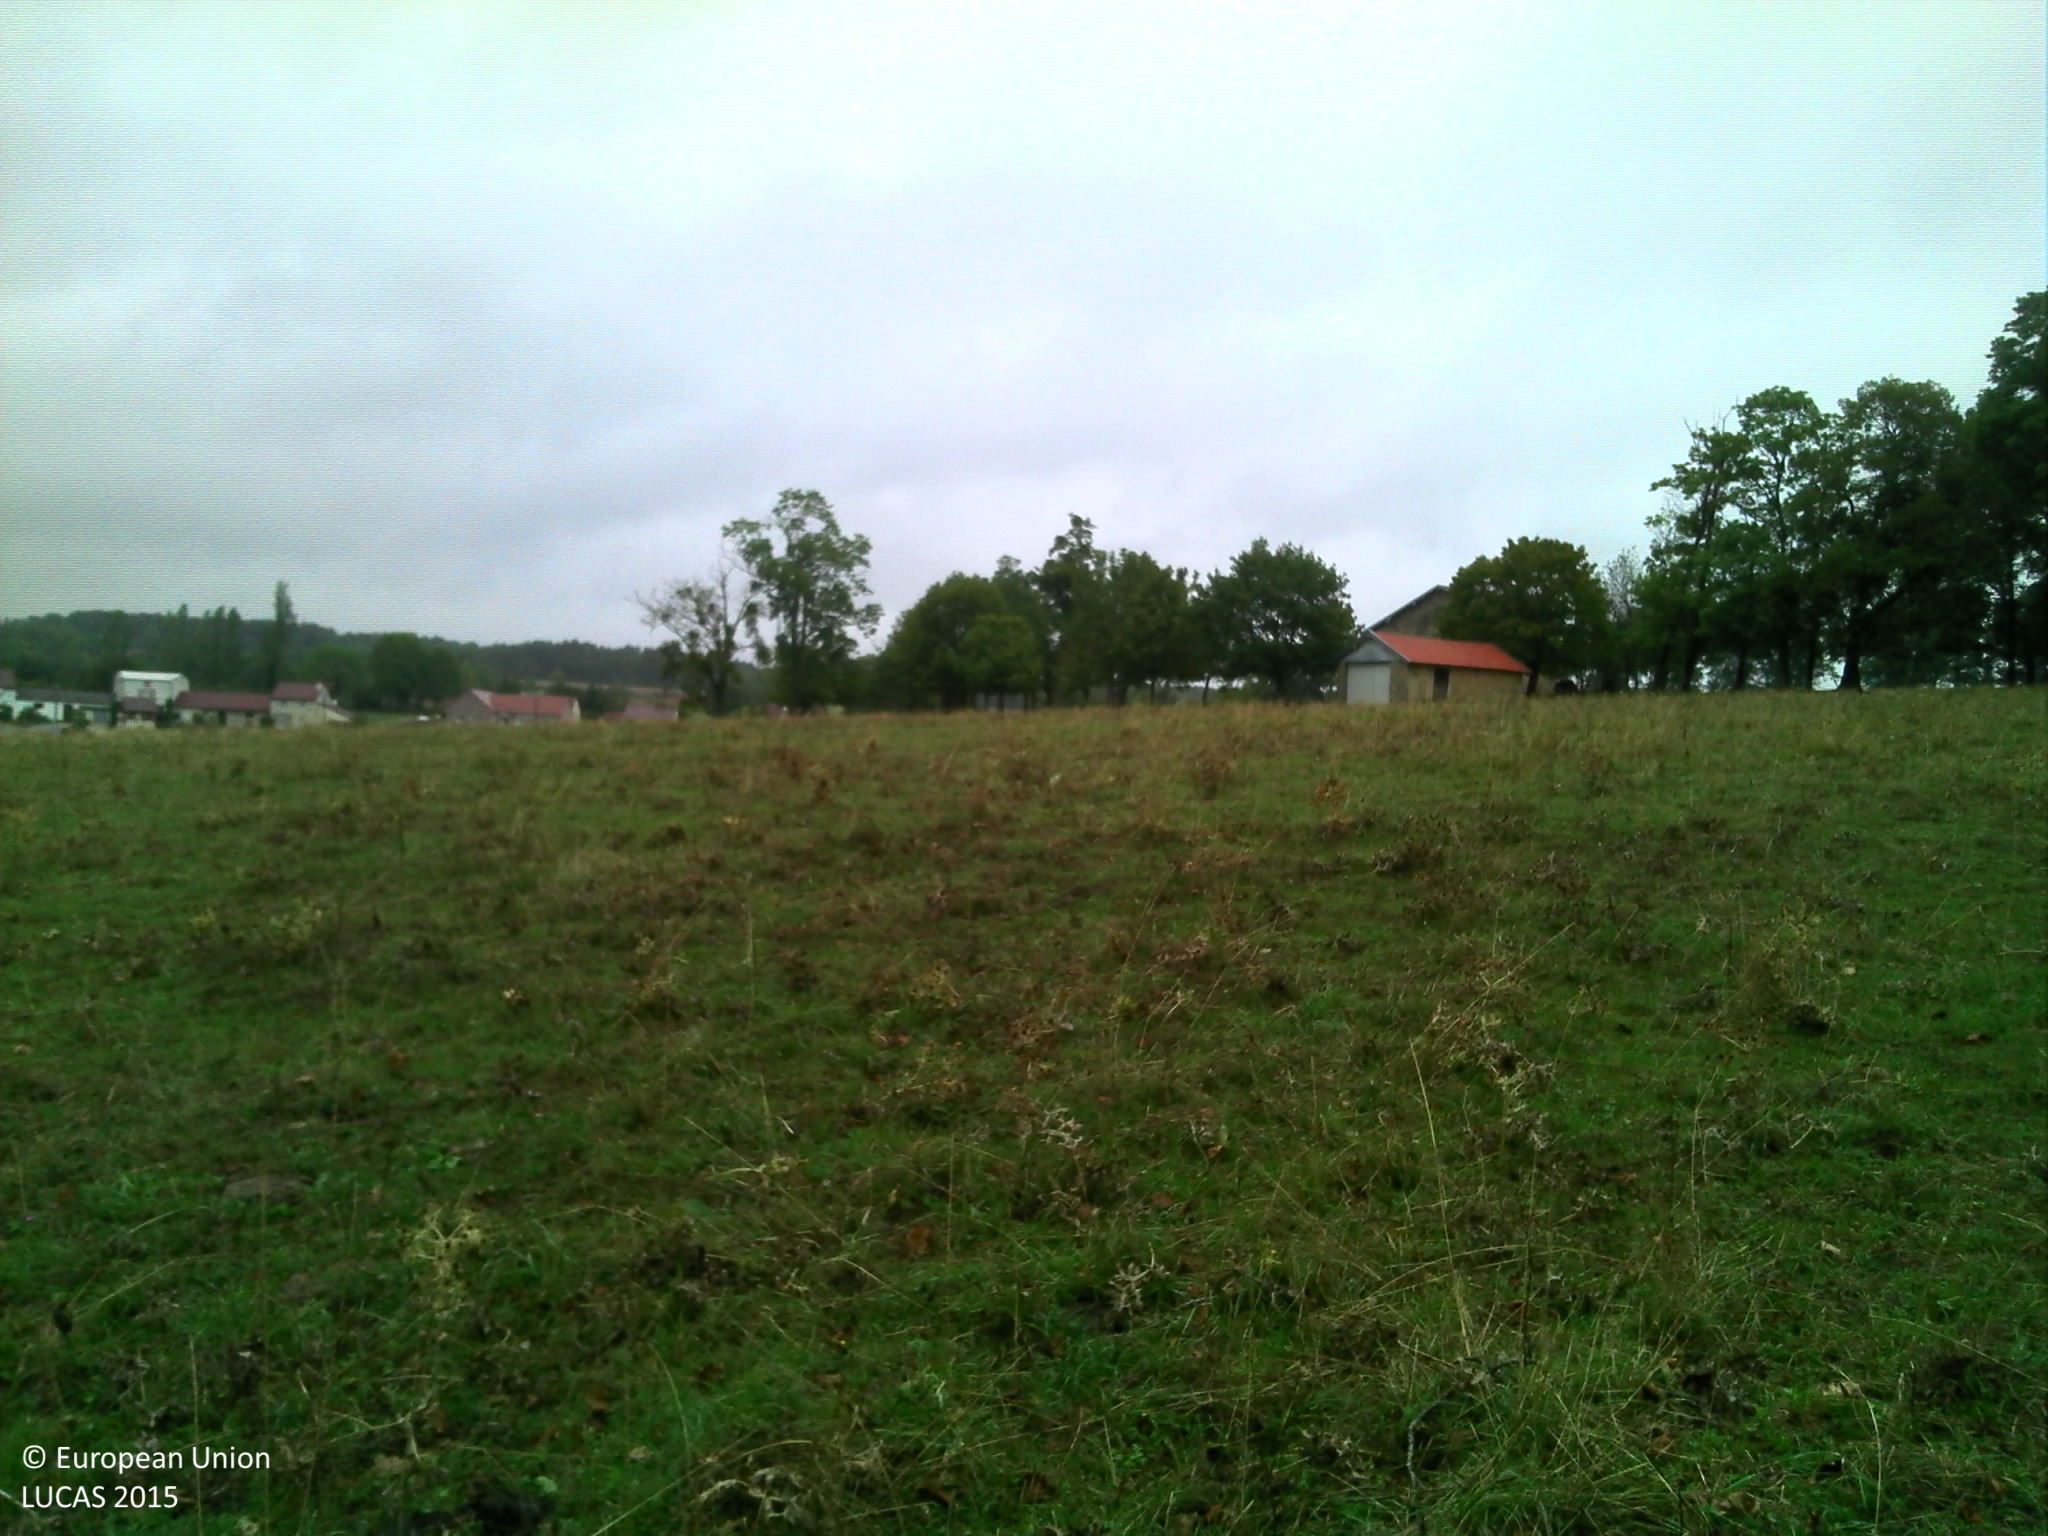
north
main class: Grassland
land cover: Grassland without tree/shrub cover
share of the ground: > 75 %
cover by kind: herbaceous plants 100 %
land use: Agriculture (excluding fallow land and kitchen gardens)
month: September
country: FR
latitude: 47.0536
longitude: 4.7744
